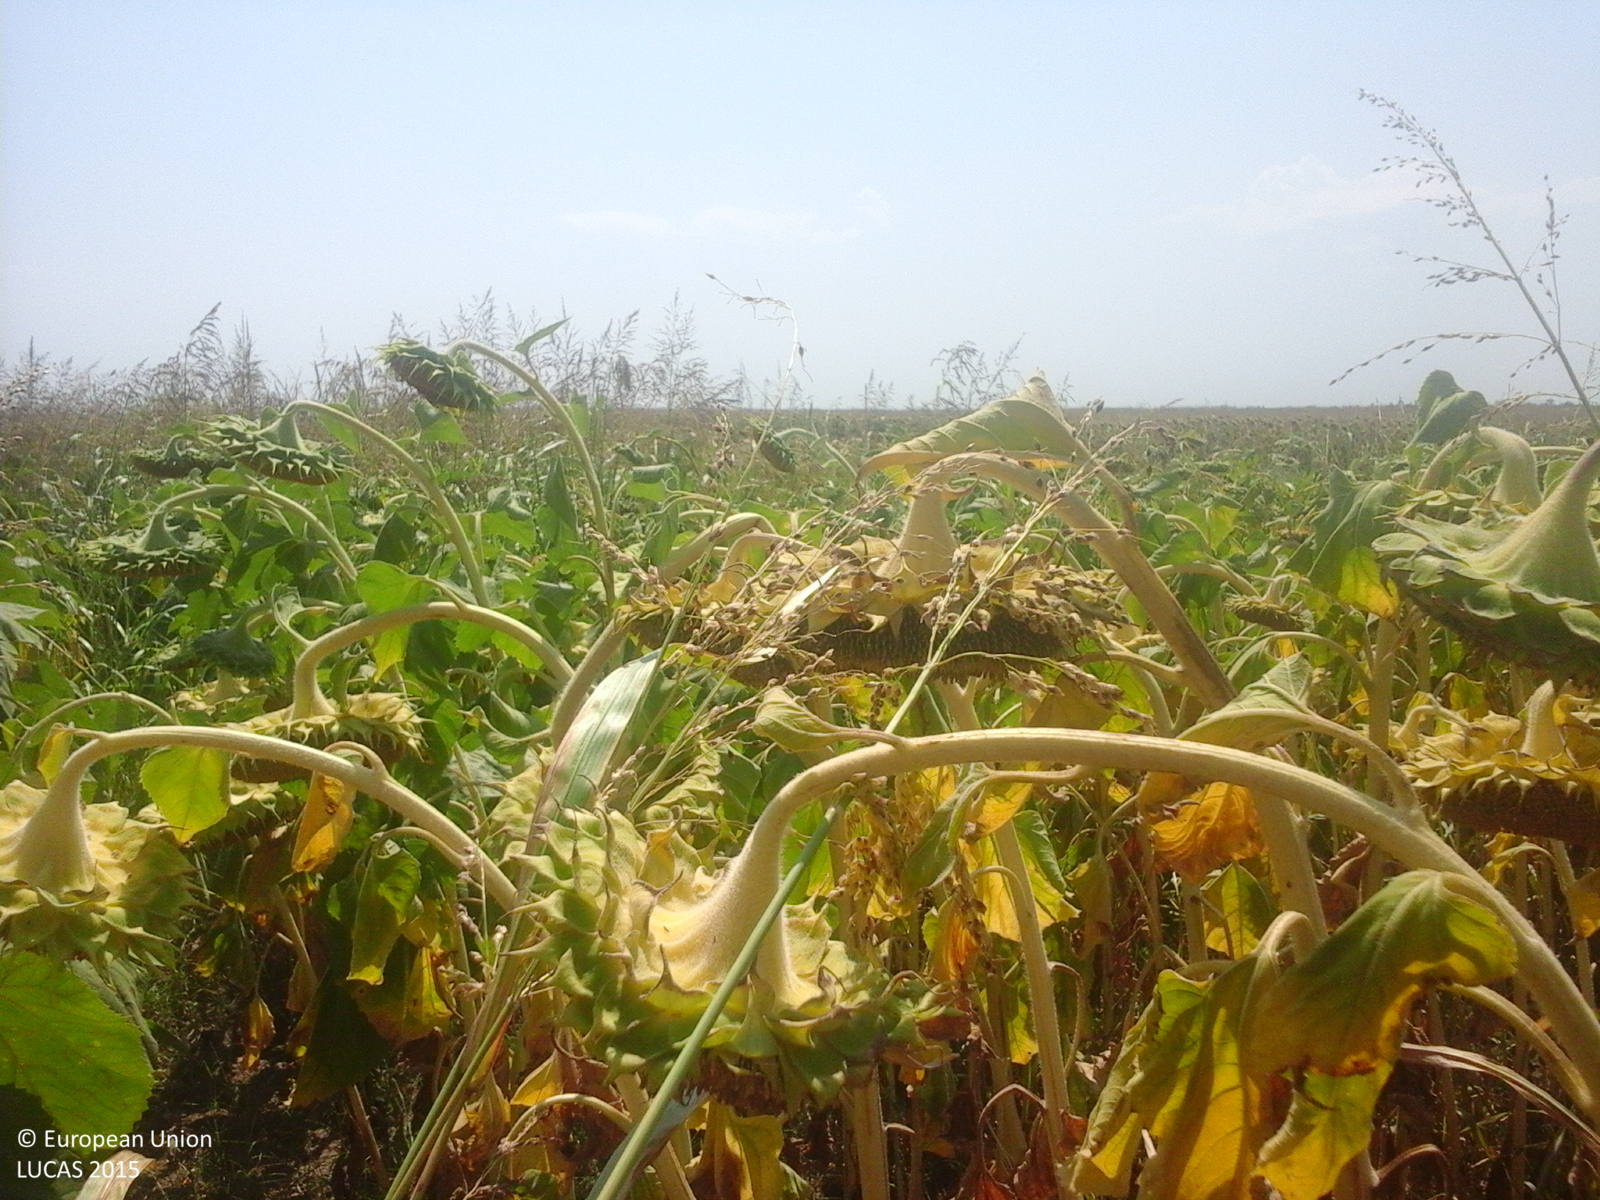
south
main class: Cropland
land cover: Sunflower
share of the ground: > 75 %
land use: Agriculture (excluding fallow land and kitchen gardens)
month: August
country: RO
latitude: 45.2163
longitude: 27.7697
